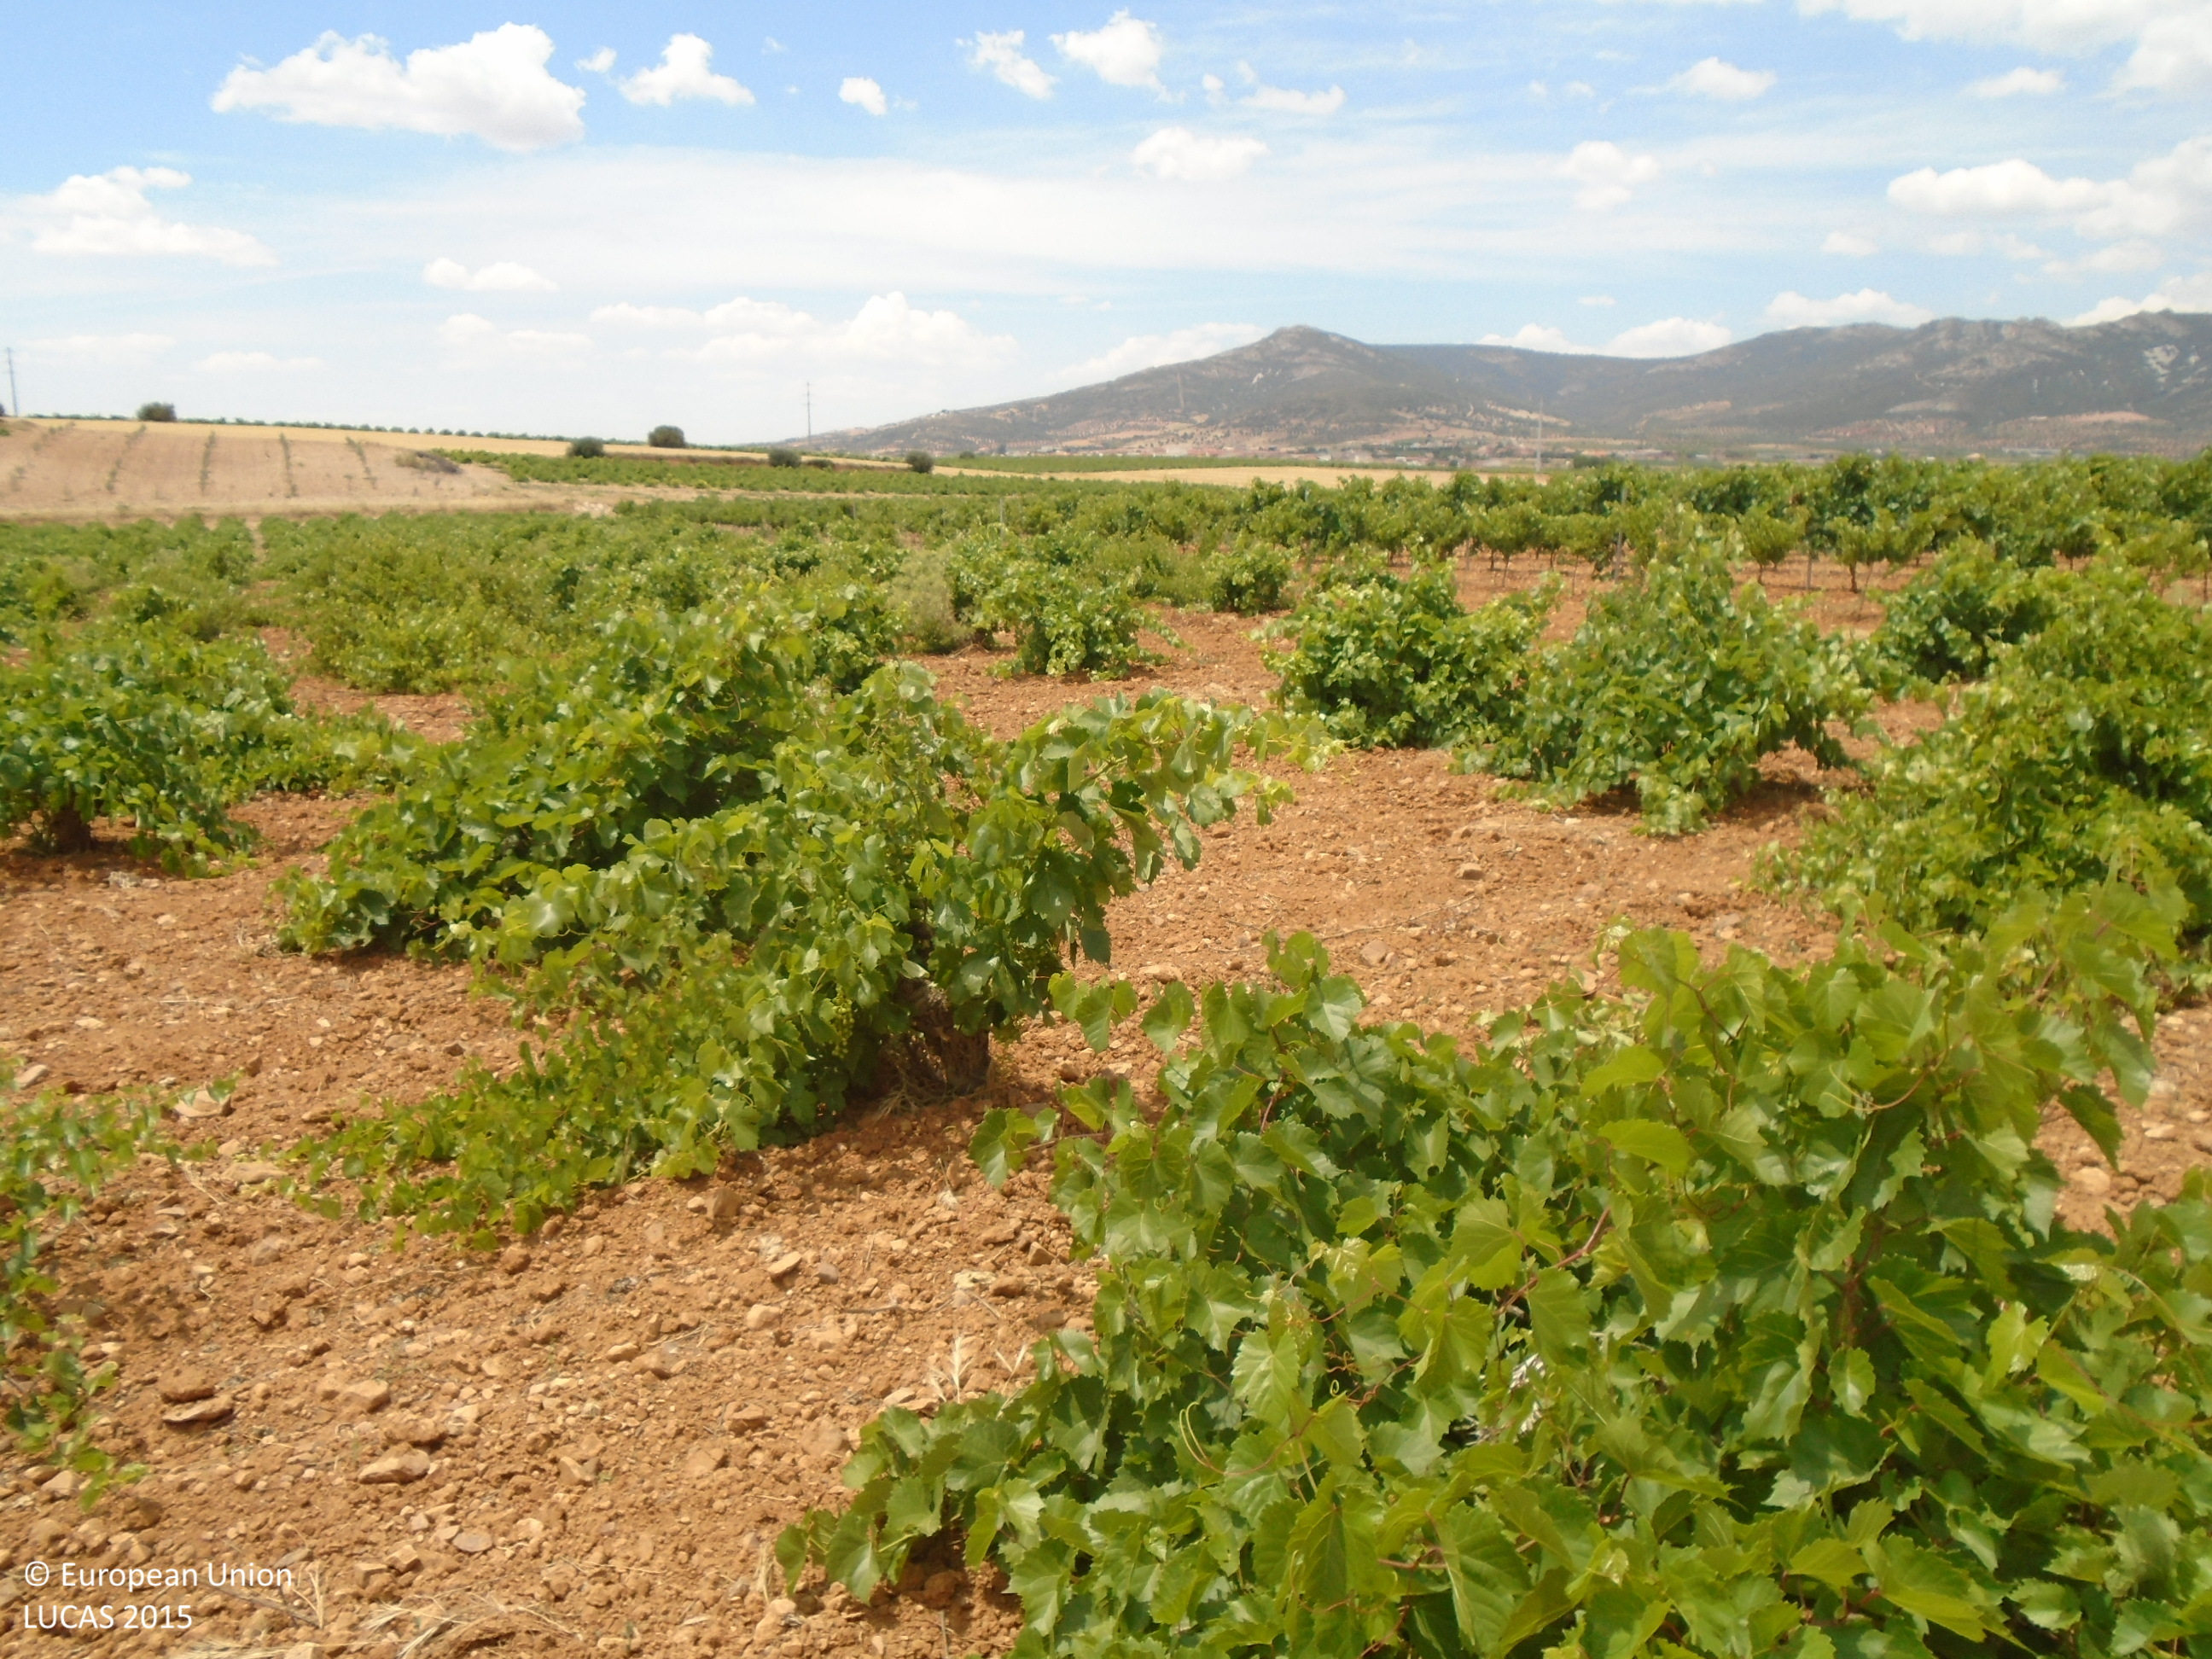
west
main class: Cropland
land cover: Vineyards
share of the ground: 25 - 50 %
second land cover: Other bare soil
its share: > 75 %
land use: Agriculture (excluding fallow land and kitchen gardens)
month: June
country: ES
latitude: 39.2261
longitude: -3.5843
